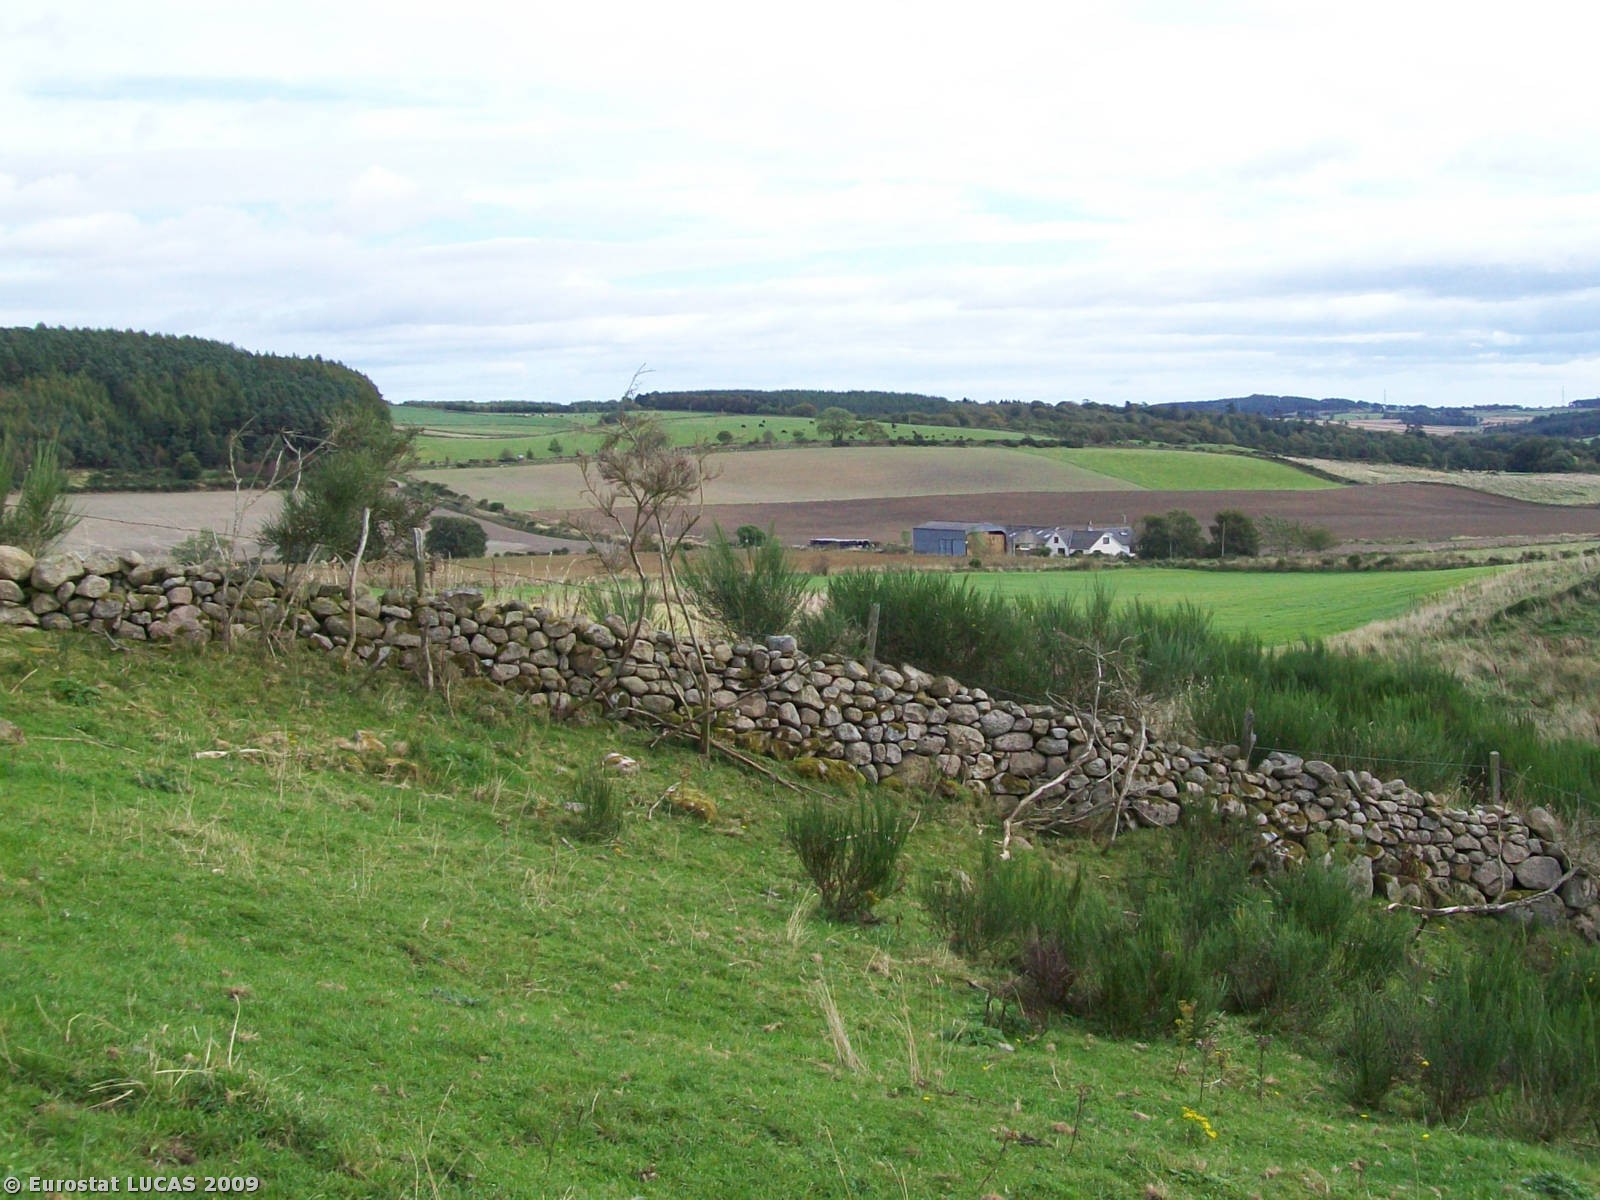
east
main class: Grassland
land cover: Grassland without tree/shrub cover
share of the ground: > 75 %
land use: Agriculture (excluding fallow land and kitchen gardens)
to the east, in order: Grassland without tree/shrub cover; Single bushes/trees; Dry stone walls; Fences; Grassland without tree/shrub cover; Rivers and streams; Grass margins; Fences; Single bushes/trees; Grassland without tree/shrub cover
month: September
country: GB
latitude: 57.2708
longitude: -2.4744
